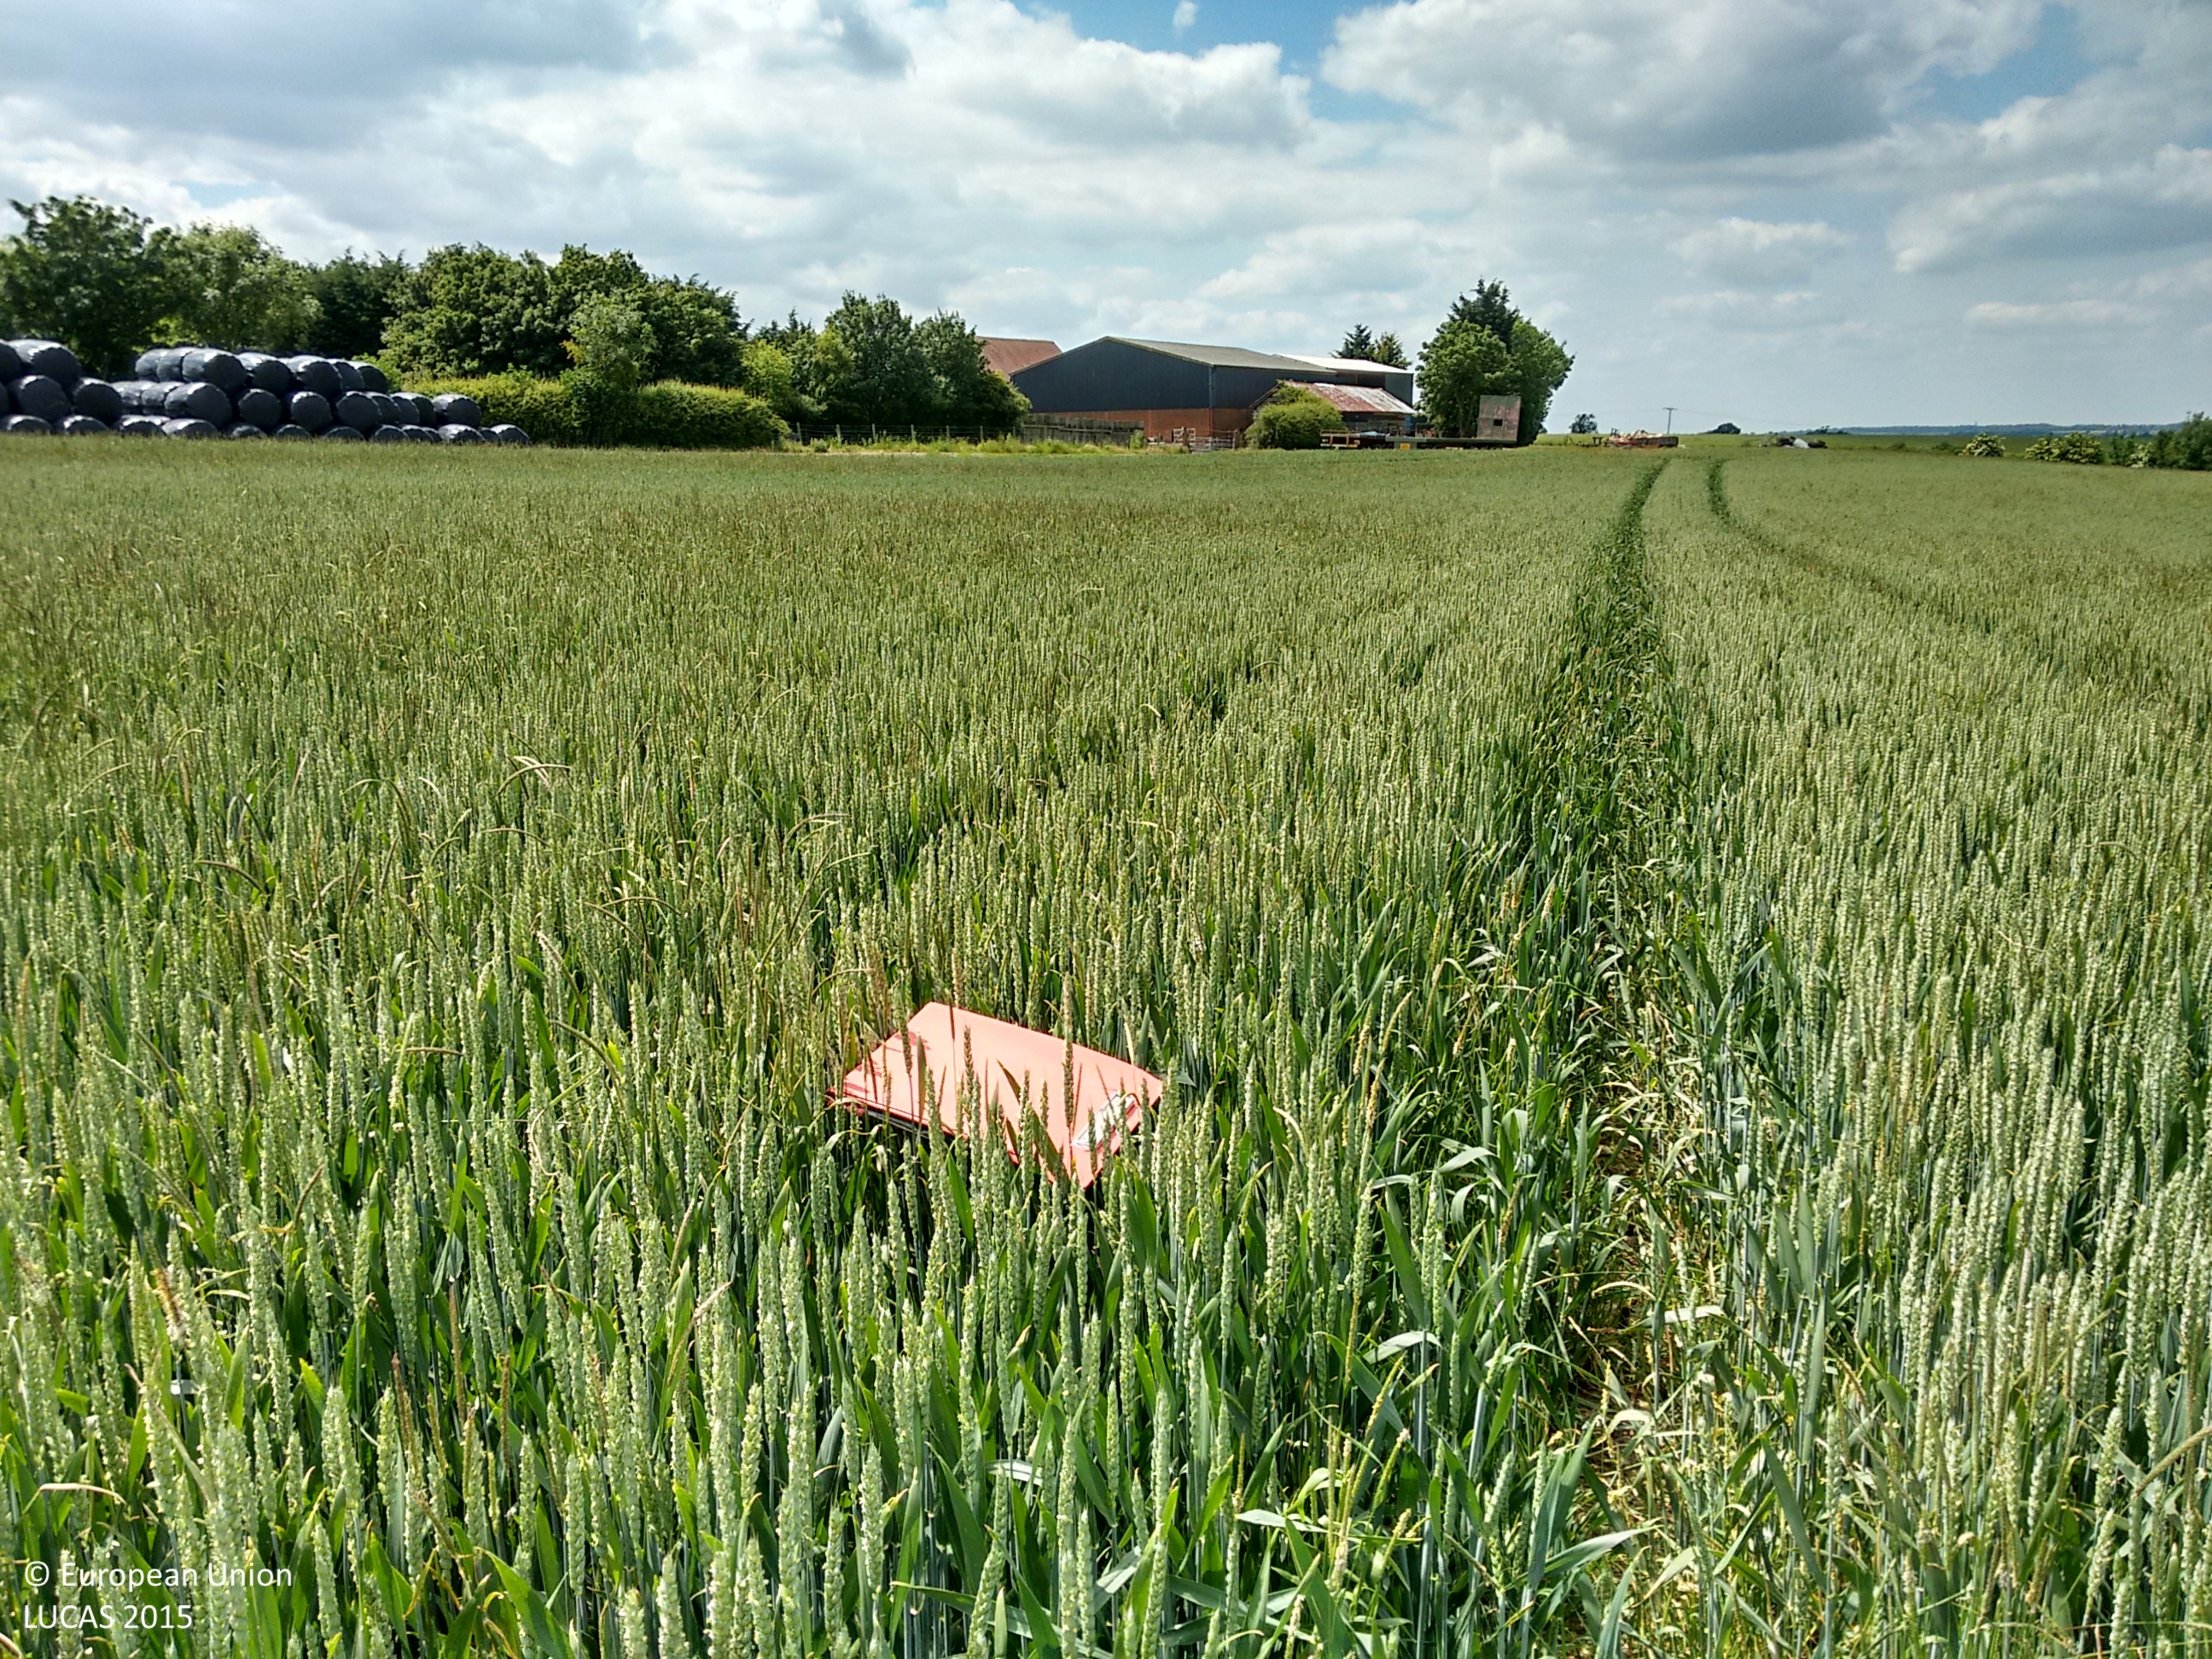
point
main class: Cropland
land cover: Common wheat
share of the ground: > 75 %
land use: Agriculture (excluding fallow land and kitchen gardens)
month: June
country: GB
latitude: 52.0759
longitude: -0.6769
